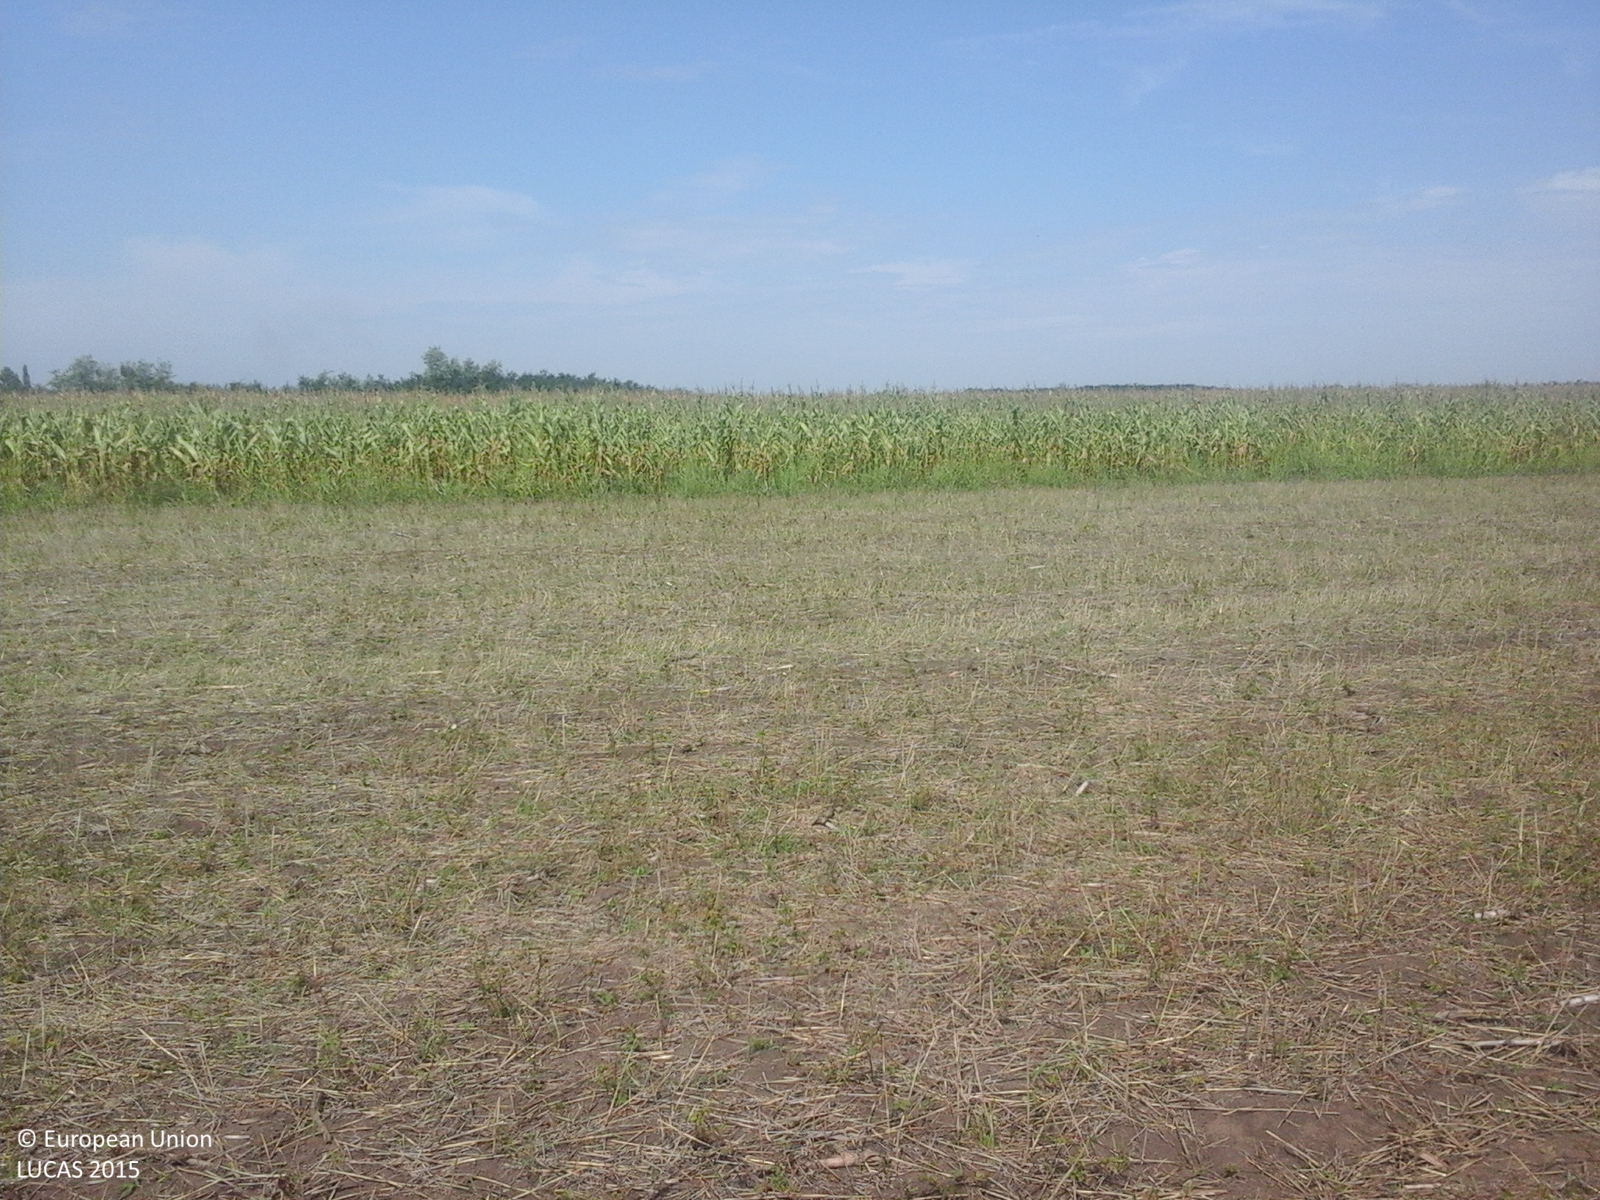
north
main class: Cropland
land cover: Durum wheat
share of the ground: 10 - 25 %
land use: Agriculture (excluding fallow land and kitchen gardens)
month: August
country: RO
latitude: 46.4225
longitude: 21.4744
